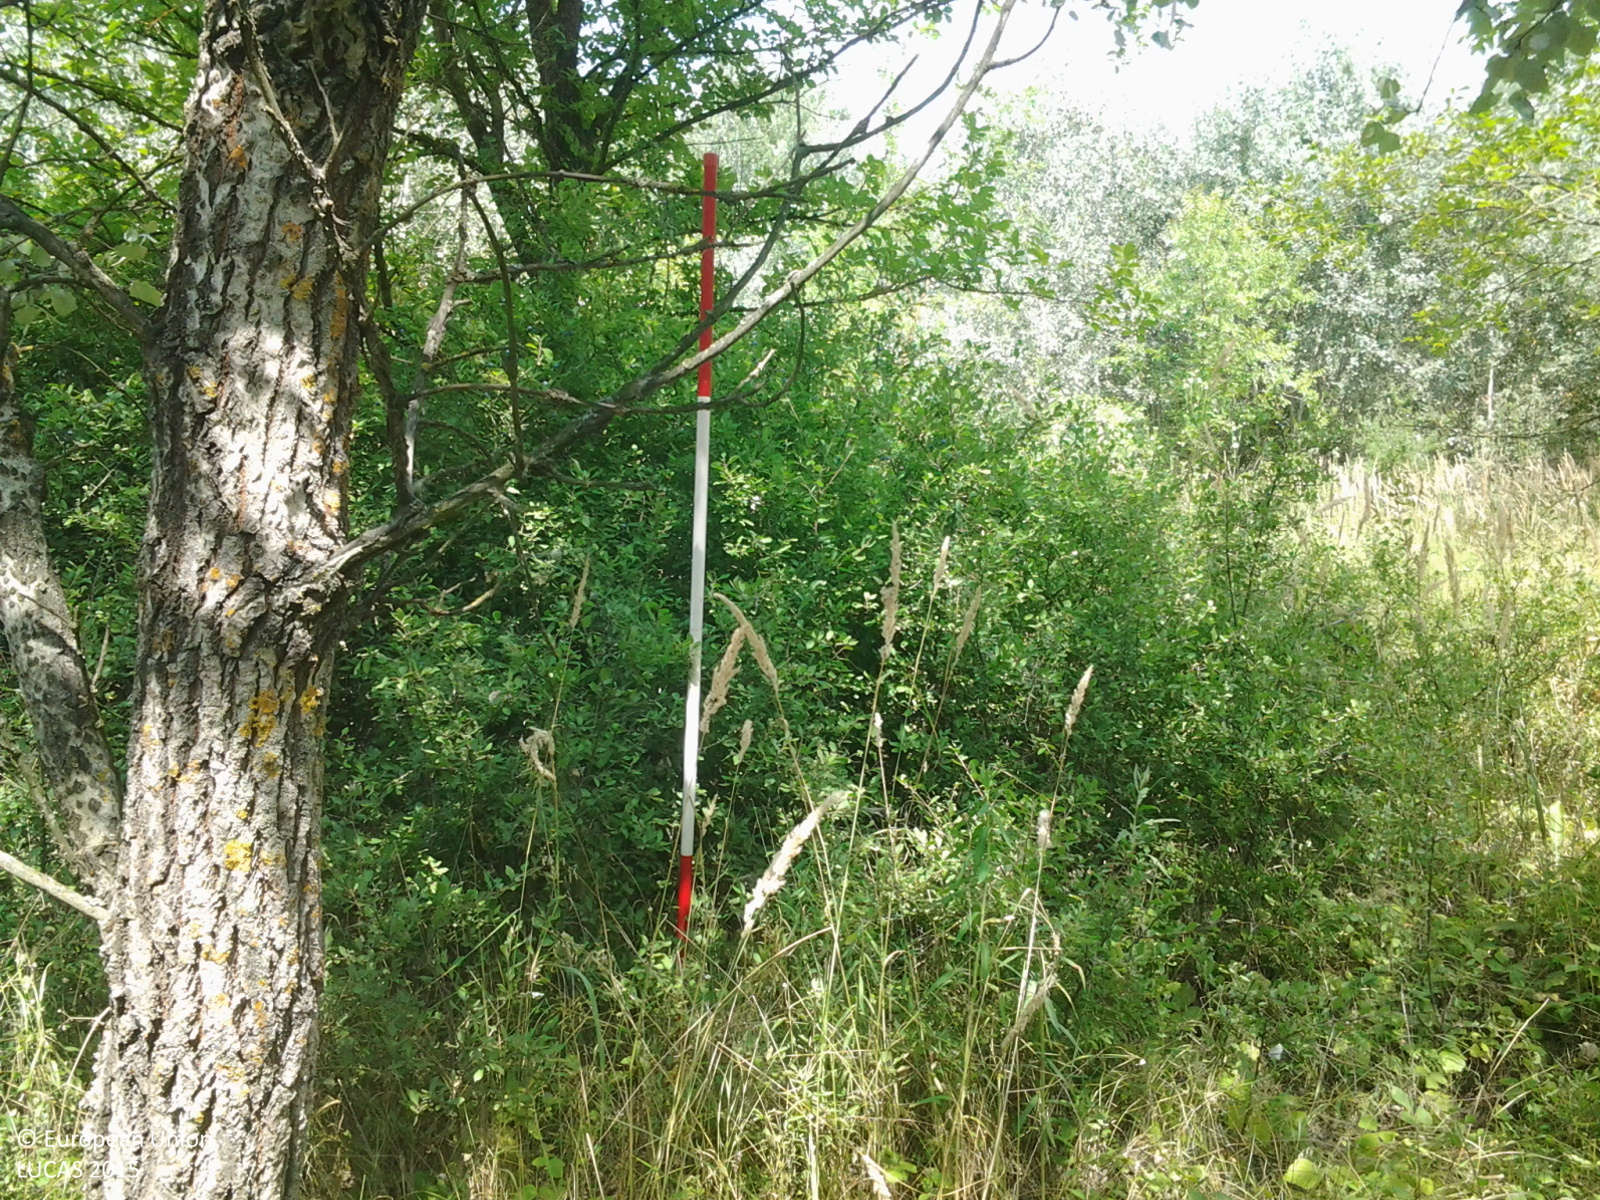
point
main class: Woodland
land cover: Broadleaved woodland
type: non-riverine alder, birch or aspen forest
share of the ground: > 75 %
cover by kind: broadleaved forest trees 75 %, herbaceous plants 15 %, shrubs 10 %
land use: Forestry
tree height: > 5 m
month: July
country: HU
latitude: 46.8366
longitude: 21.5121
